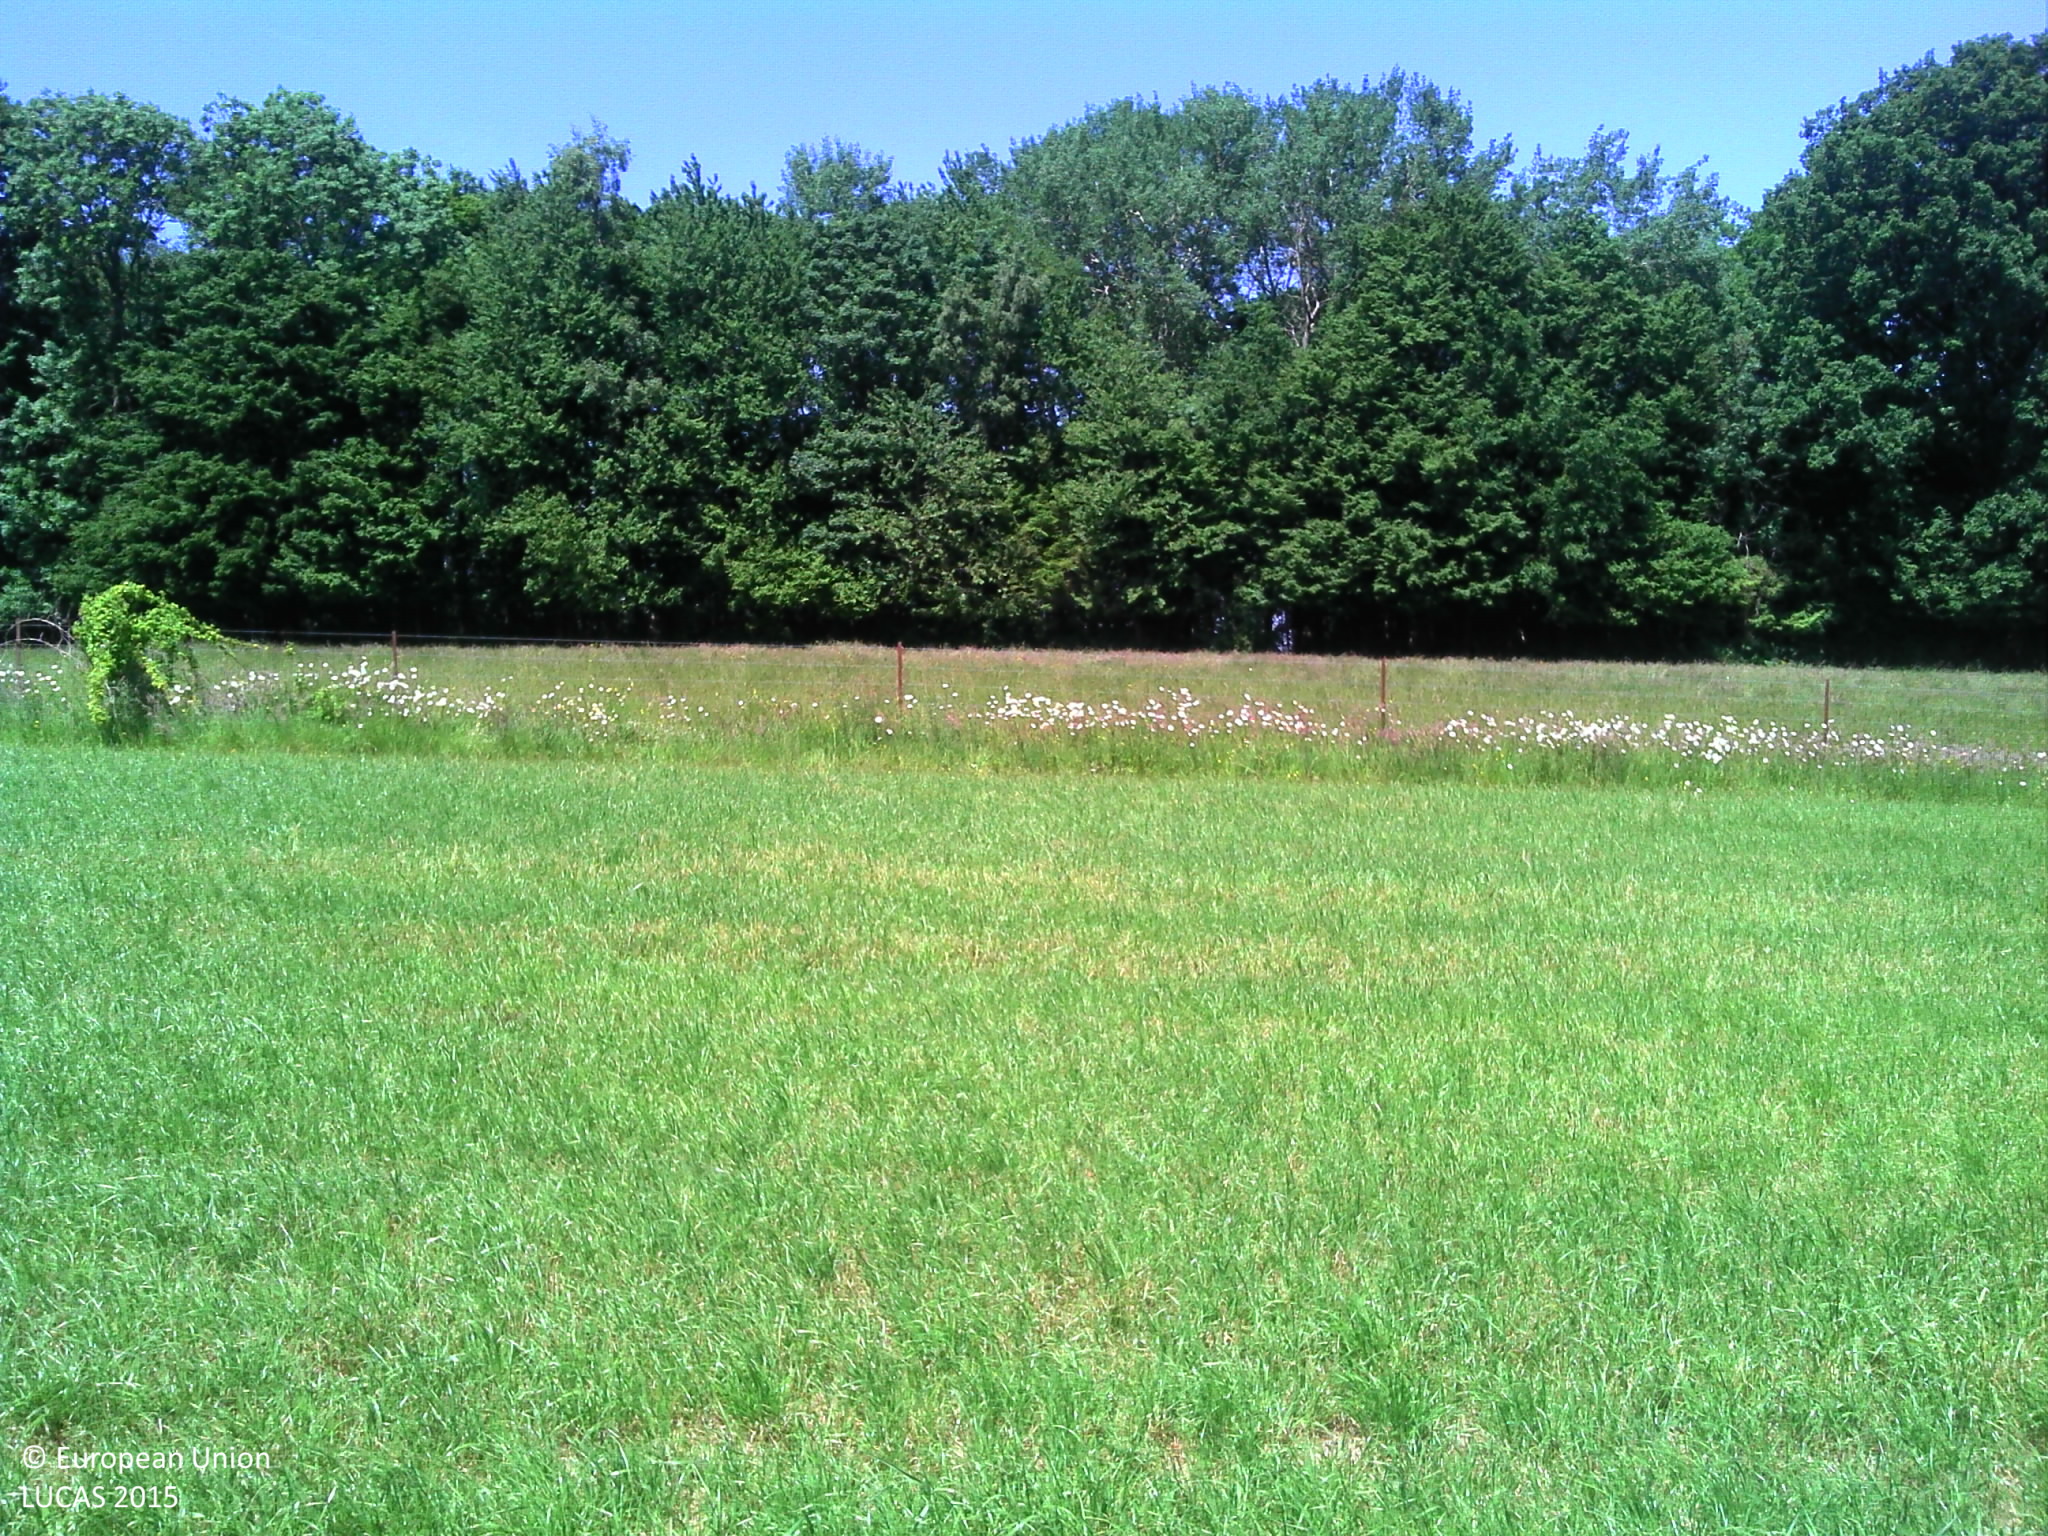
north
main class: Cropland
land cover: Temporary grasslands
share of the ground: > 75 %
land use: Agriculture (excluding fallow land and kitchen gardens)
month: June
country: FR
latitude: 49.8933
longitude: 4.2183
